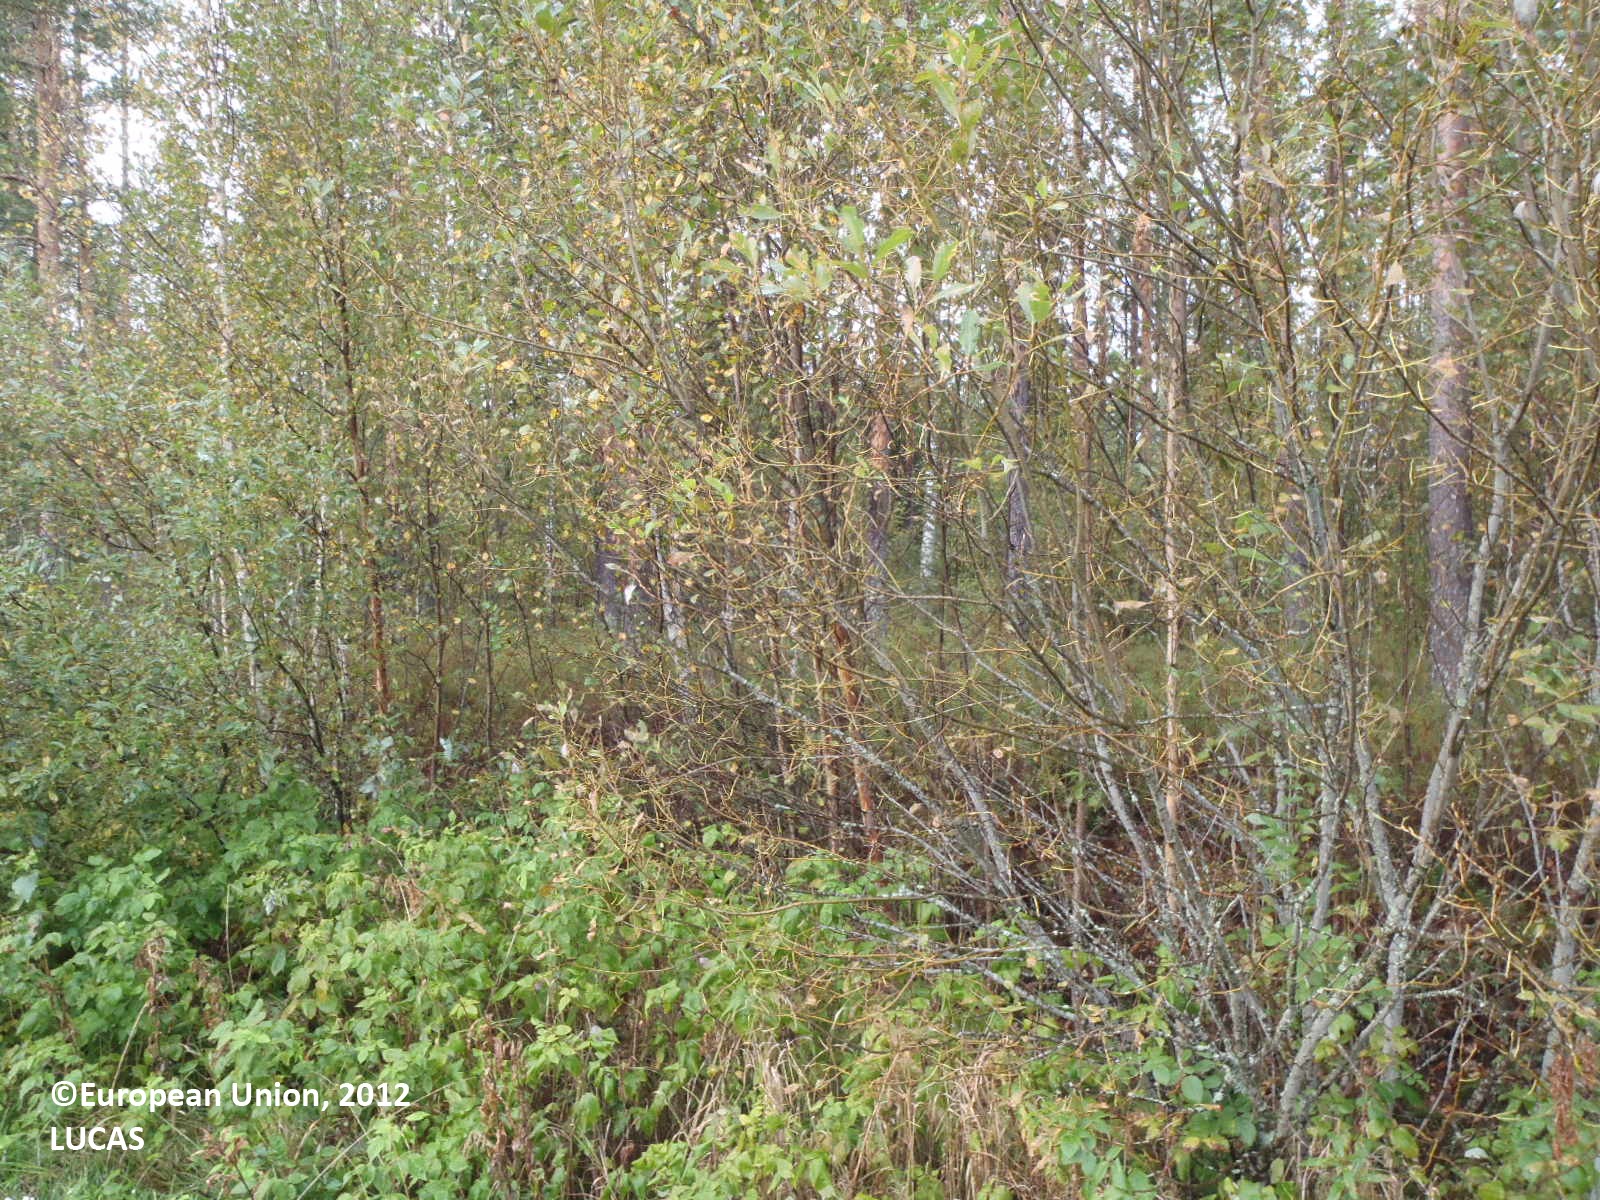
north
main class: Grassland
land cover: Grassland without tree/shrub cover
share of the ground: > 75 %
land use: Agriculture (excluding fallow land and kitchen gardens)
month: September
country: FI
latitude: 61.7061
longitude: 22.4868
